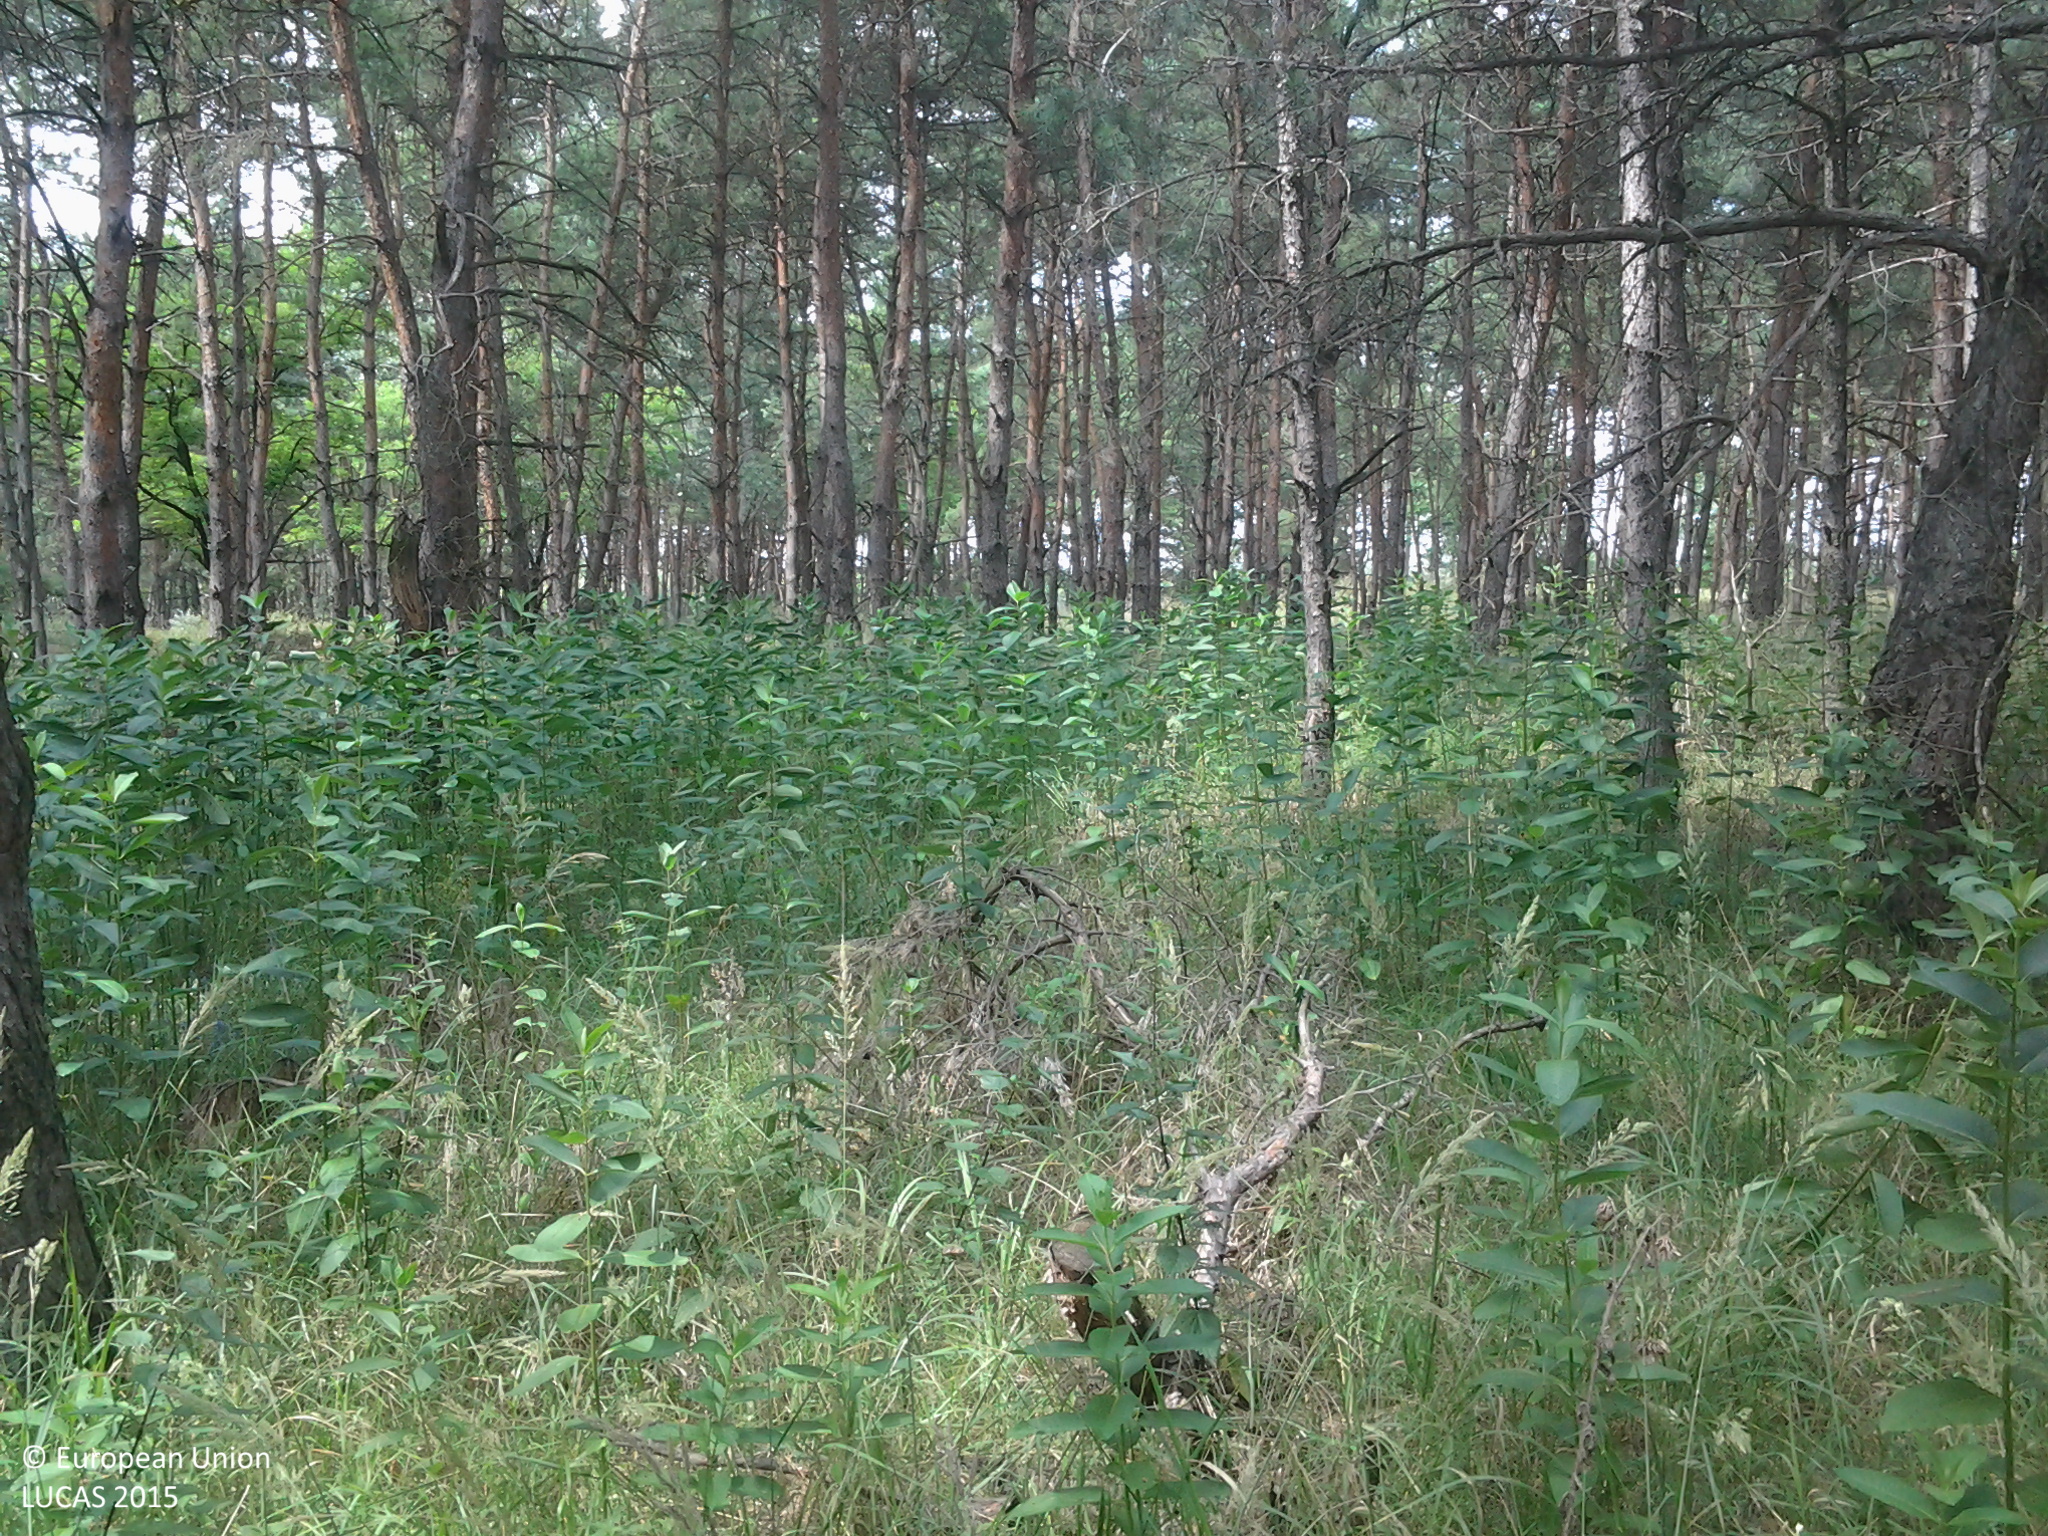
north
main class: Woodland
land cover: Pine dominated coniferous woodland
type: hemiboreal forest and nemoral coniferous forest and mixed broadleaved-coniferous forest
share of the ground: 50 - 75 %
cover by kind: coniferous forest trees 75 %, herbaceous plants 25 %
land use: Forestry
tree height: > 5 m
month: June
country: HU
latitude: 46.6325
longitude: 19.7249
